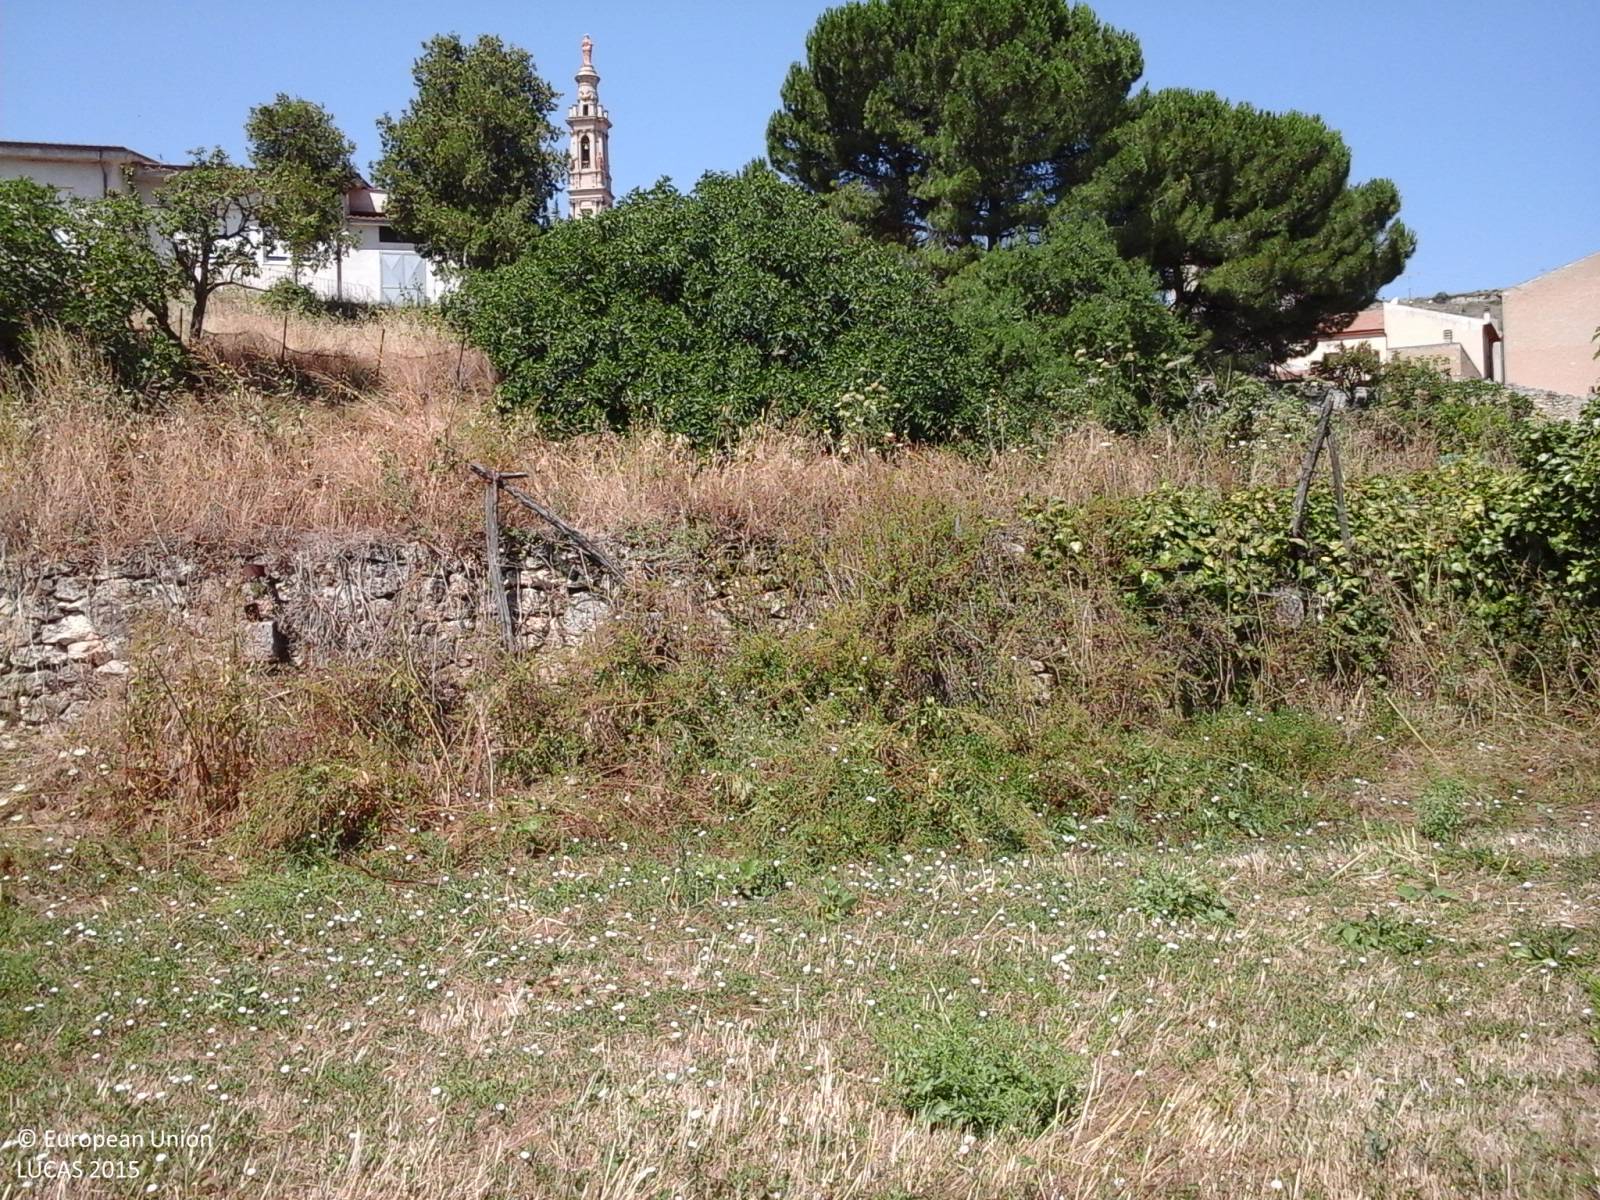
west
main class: Grassland
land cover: Grassland without tree/shrub cover
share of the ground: > 75 %
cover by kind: herbaceous plants 100 %
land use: Agriculture (excluding fallow land and kitchen gardens)
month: July
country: IT
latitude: 40.5501
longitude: 8.8368
